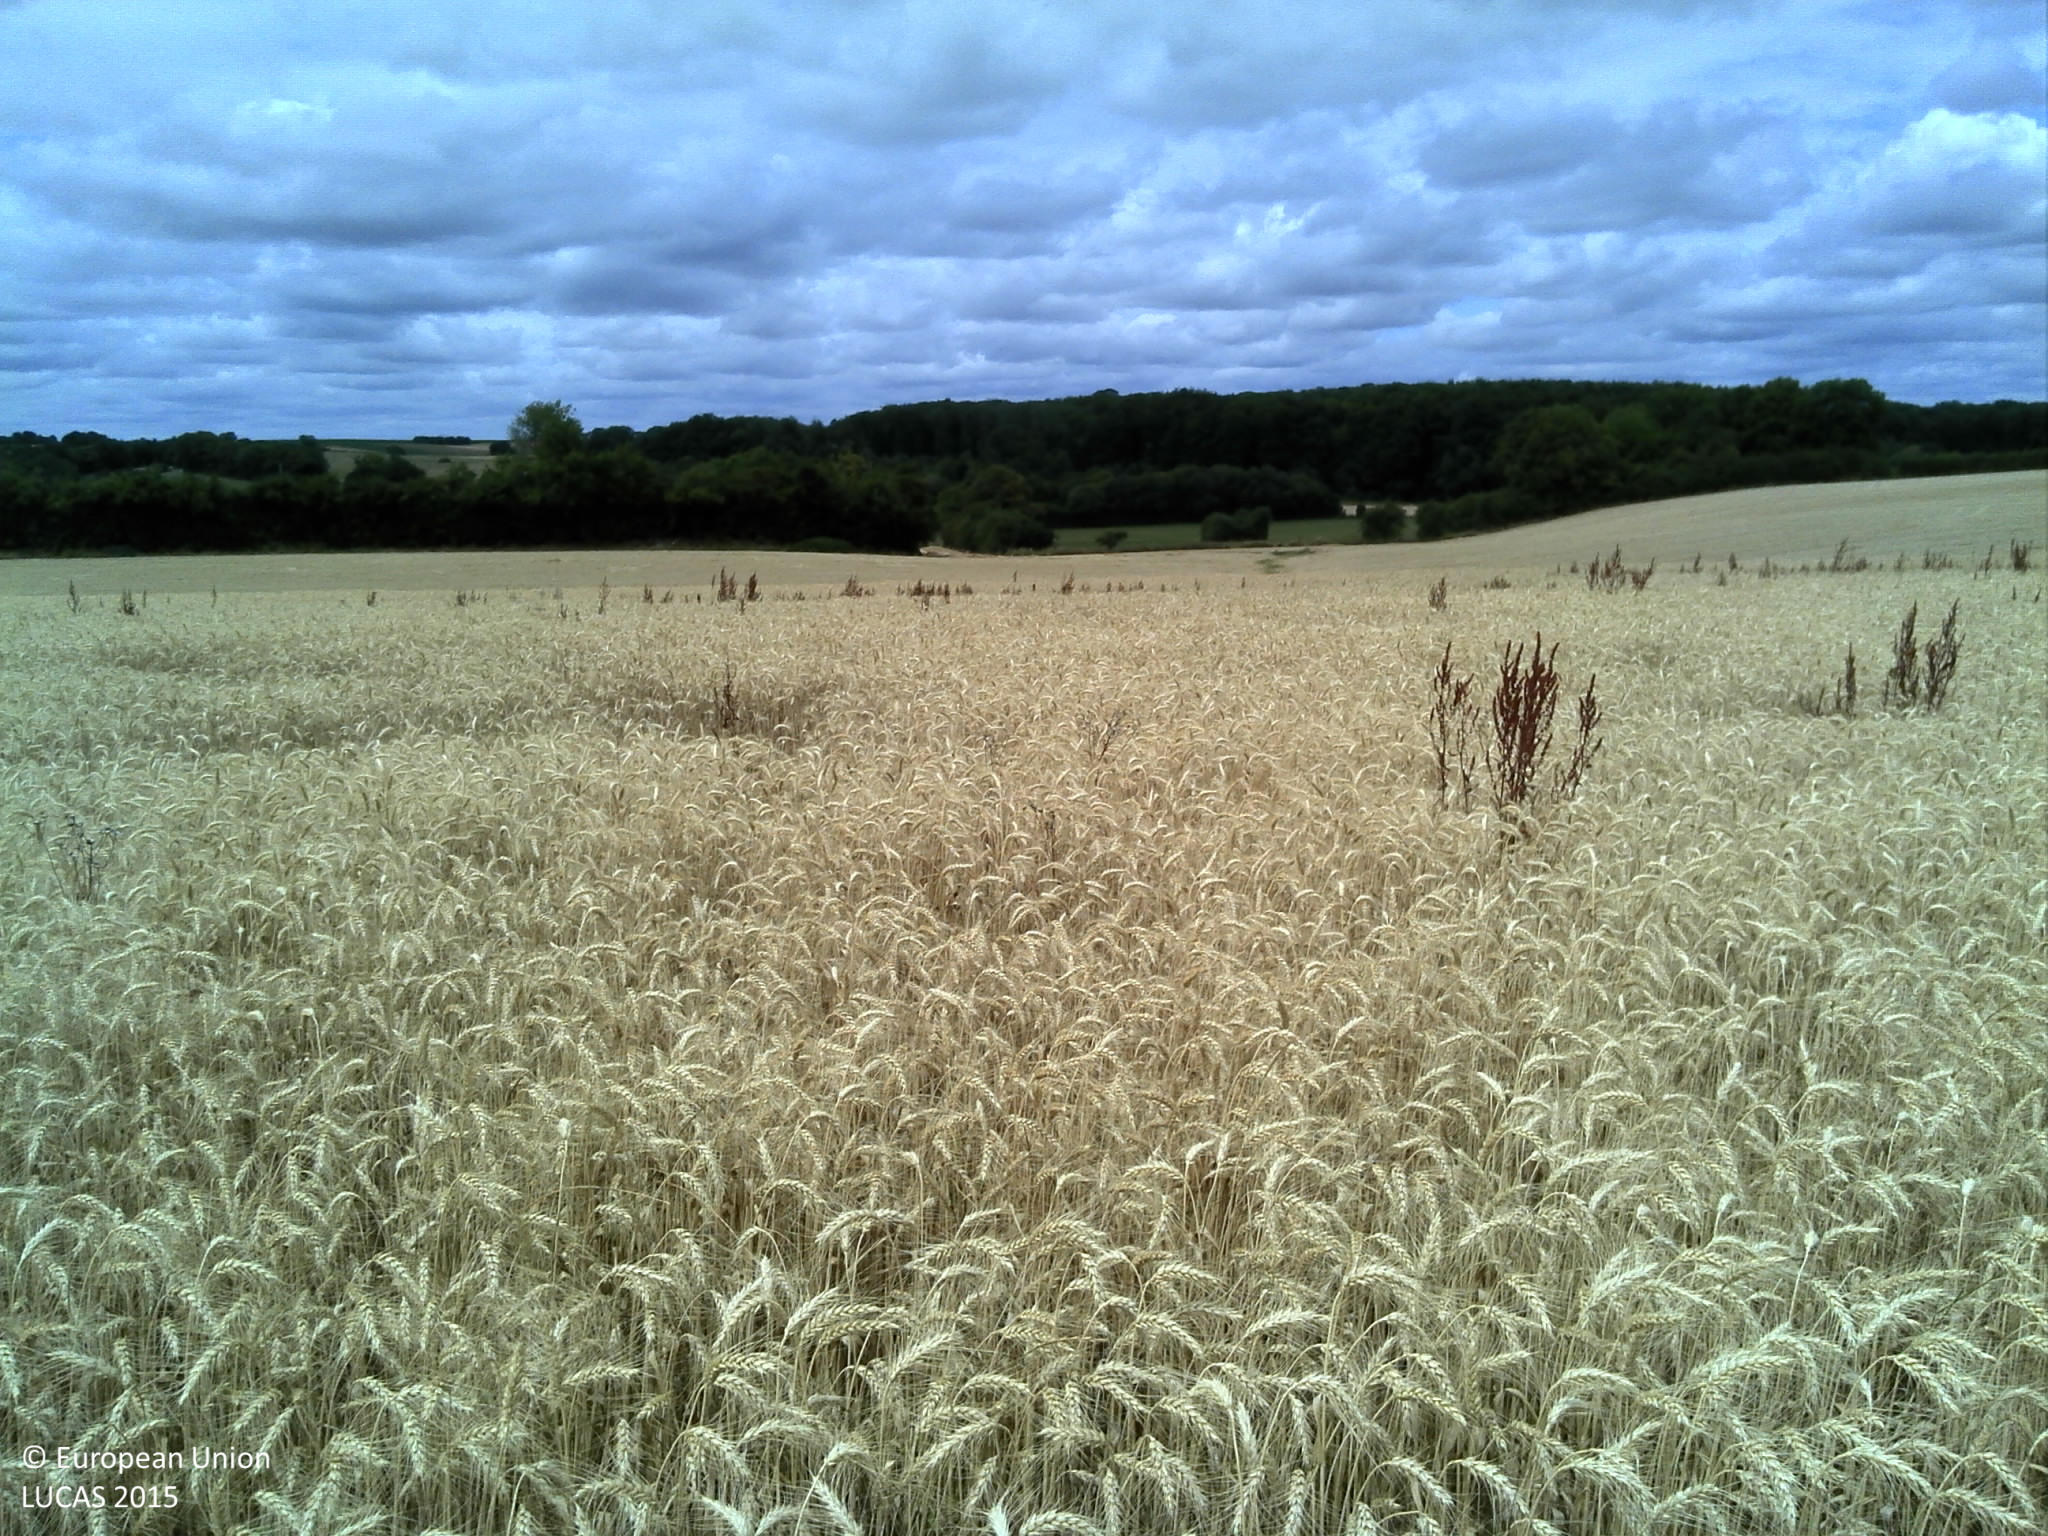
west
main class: Cropland
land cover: Durum wheat
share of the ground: > 75 %
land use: Agriculture (excluding fallow land and kitchen gardens)
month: July
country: FR
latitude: 48.1693
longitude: 6.0068
